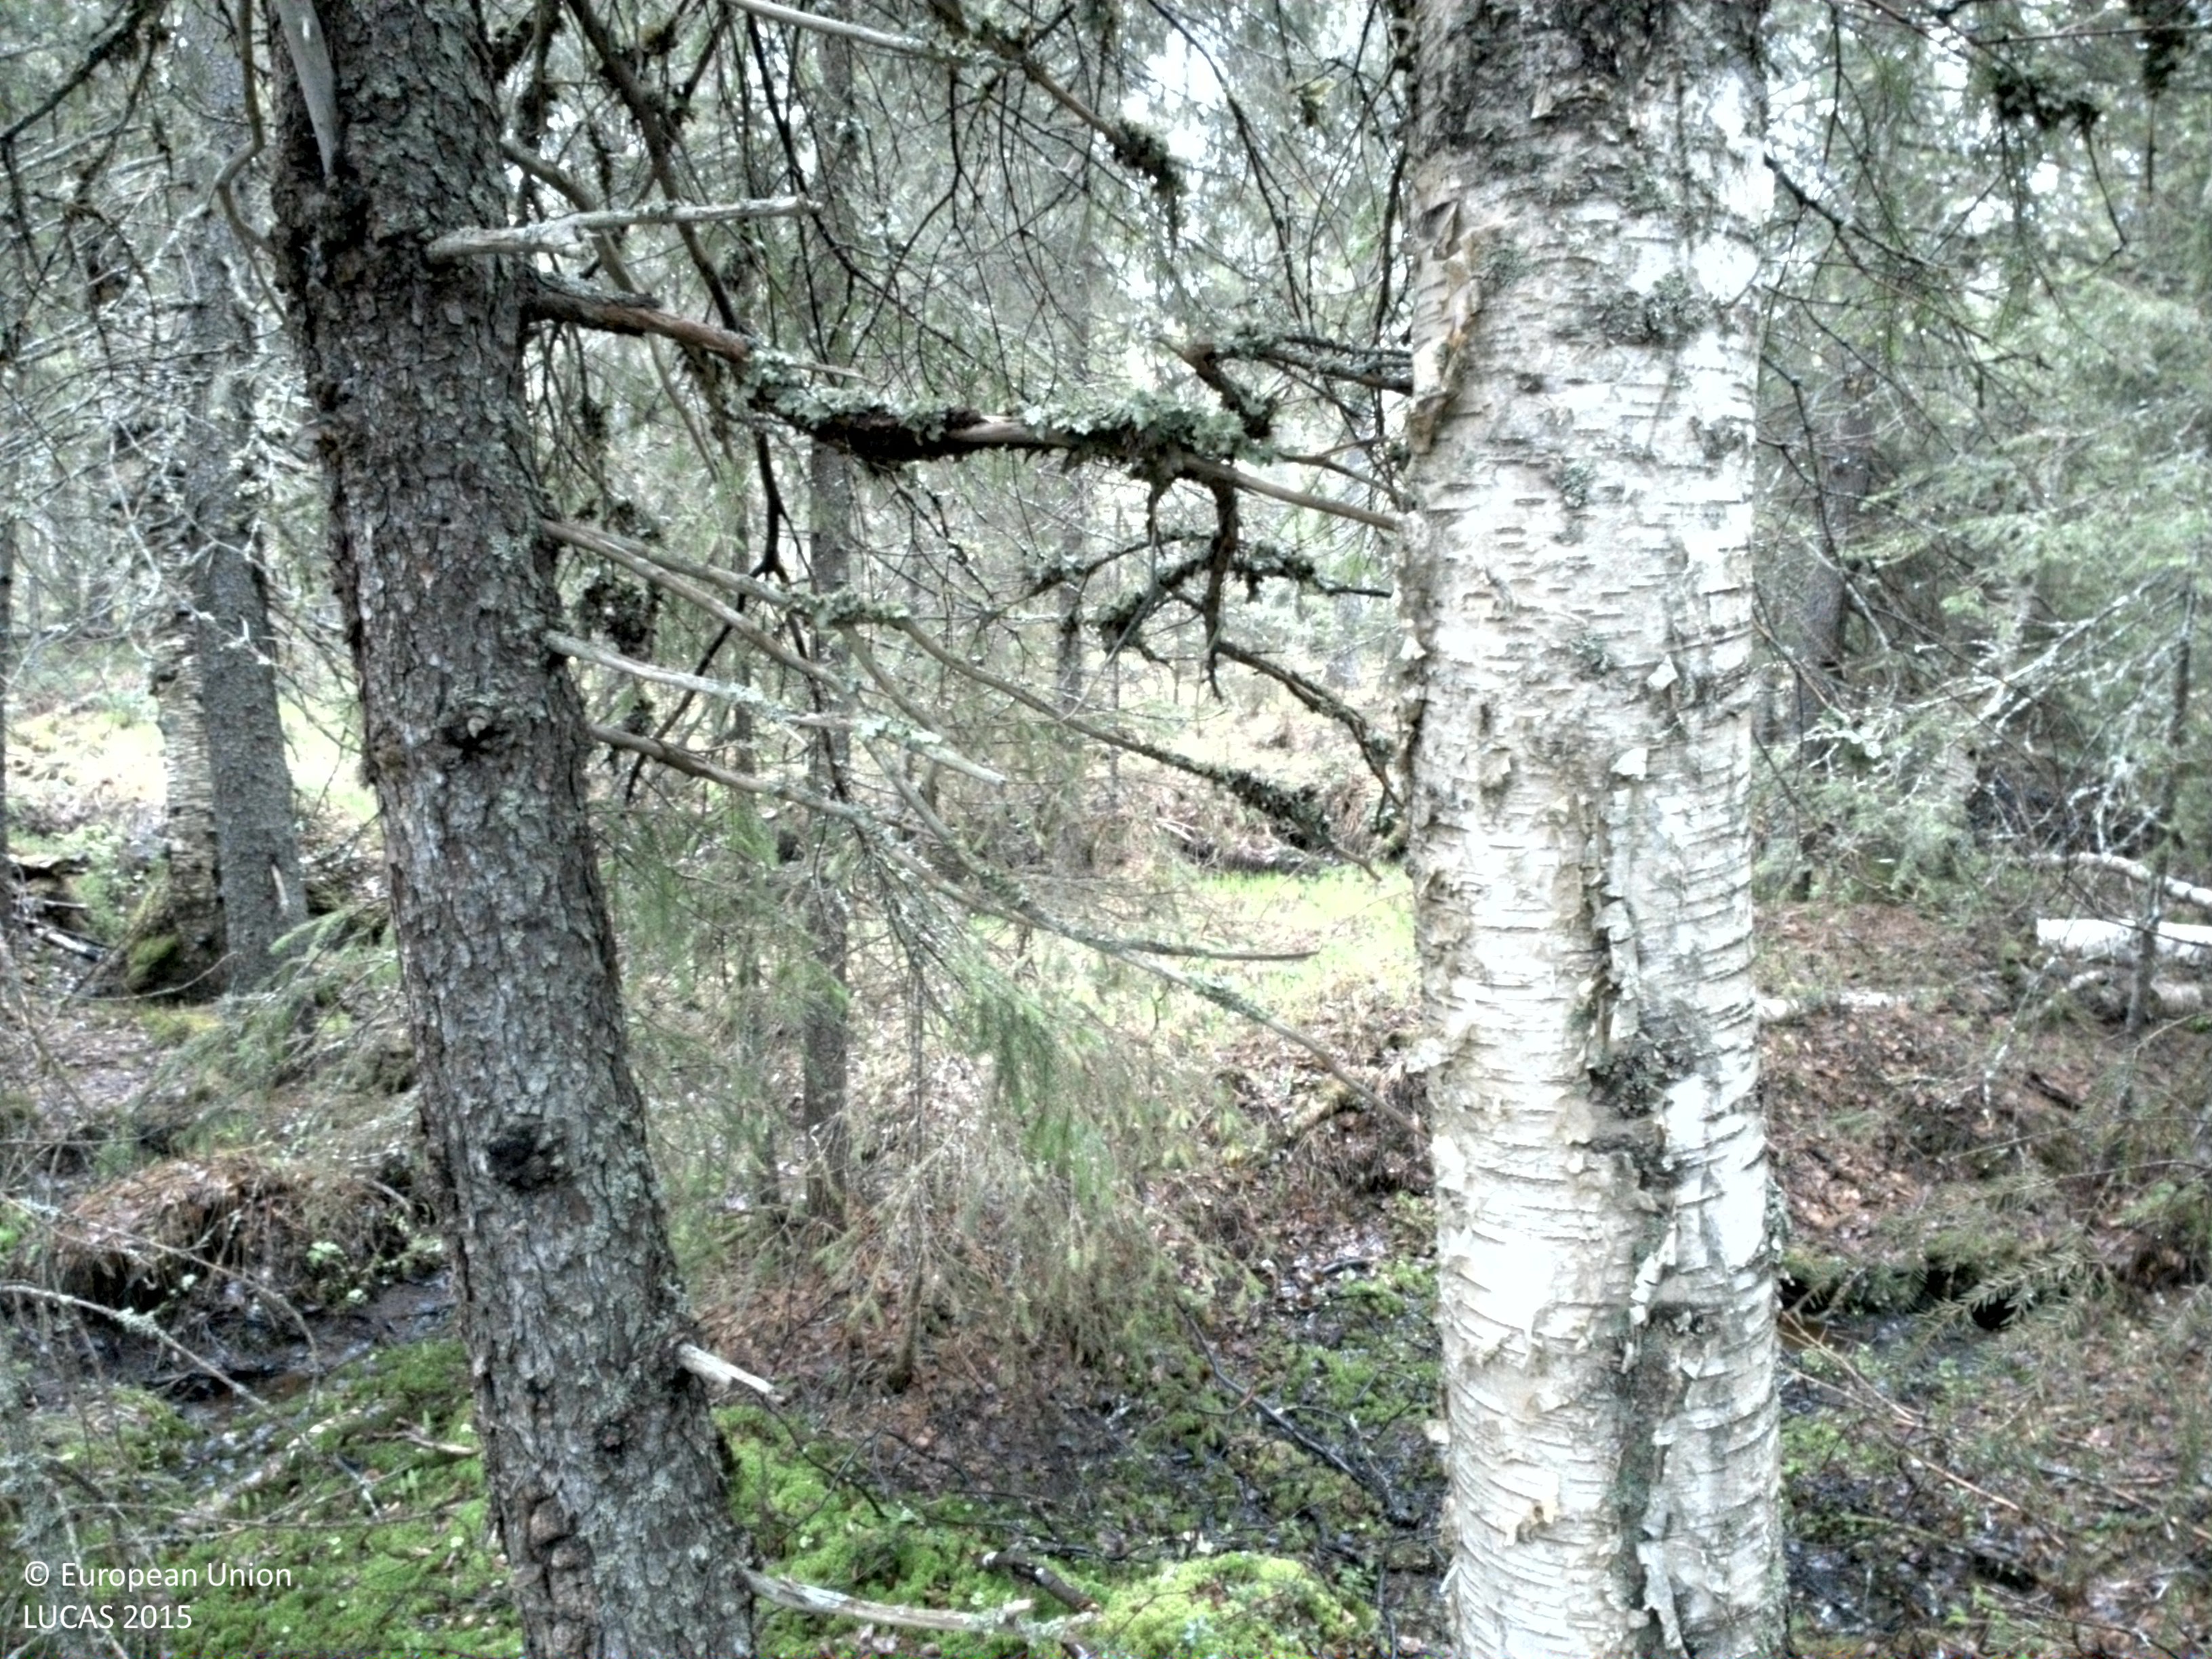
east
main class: Woodland
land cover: Spruce dominated coniferous woodland
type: boreal forest
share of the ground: 50 - 75 %
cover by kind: coniferous forest trees 65 %, shrubs 15 %, herbaceous plants 10 %, broadleaved forest trees 5 %, lichens and mosses 5 %
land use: Forestry
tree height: > 5 m
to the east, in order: Spruce dominated coniferous woodland; Rivers and streams; Spruce dominated coniferous woodland; Pine dominated mixed woodland; Other coniferous woodland; Grassland with sparse tree/shrub cover; Ditches and canals; Grass margins; Shrubland with sparse tree cover; Pine dominated mixed woodland; Spruce dominated coniferous woodland; Spruce dominated mixed woodland
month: June
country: SE
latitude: 66.0273
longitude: 23.0197
